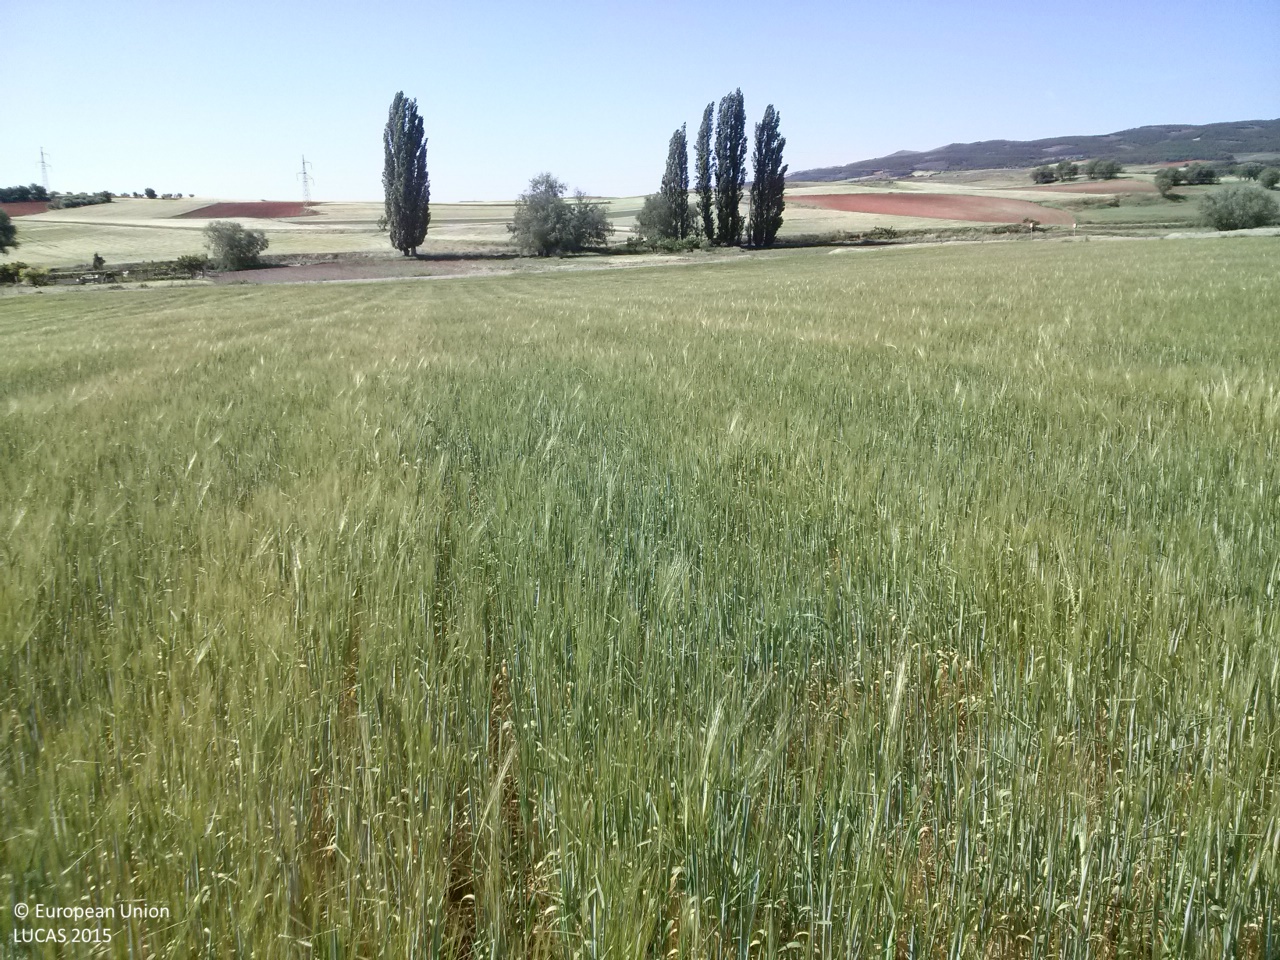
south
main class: Cropland
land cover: Barley
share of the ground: > 75 %
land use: Agriculture (excluding fallow land and kitchen gardens)
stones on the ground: < 10 %
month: May
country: ES
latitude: 39.9924
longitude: -2.7991
